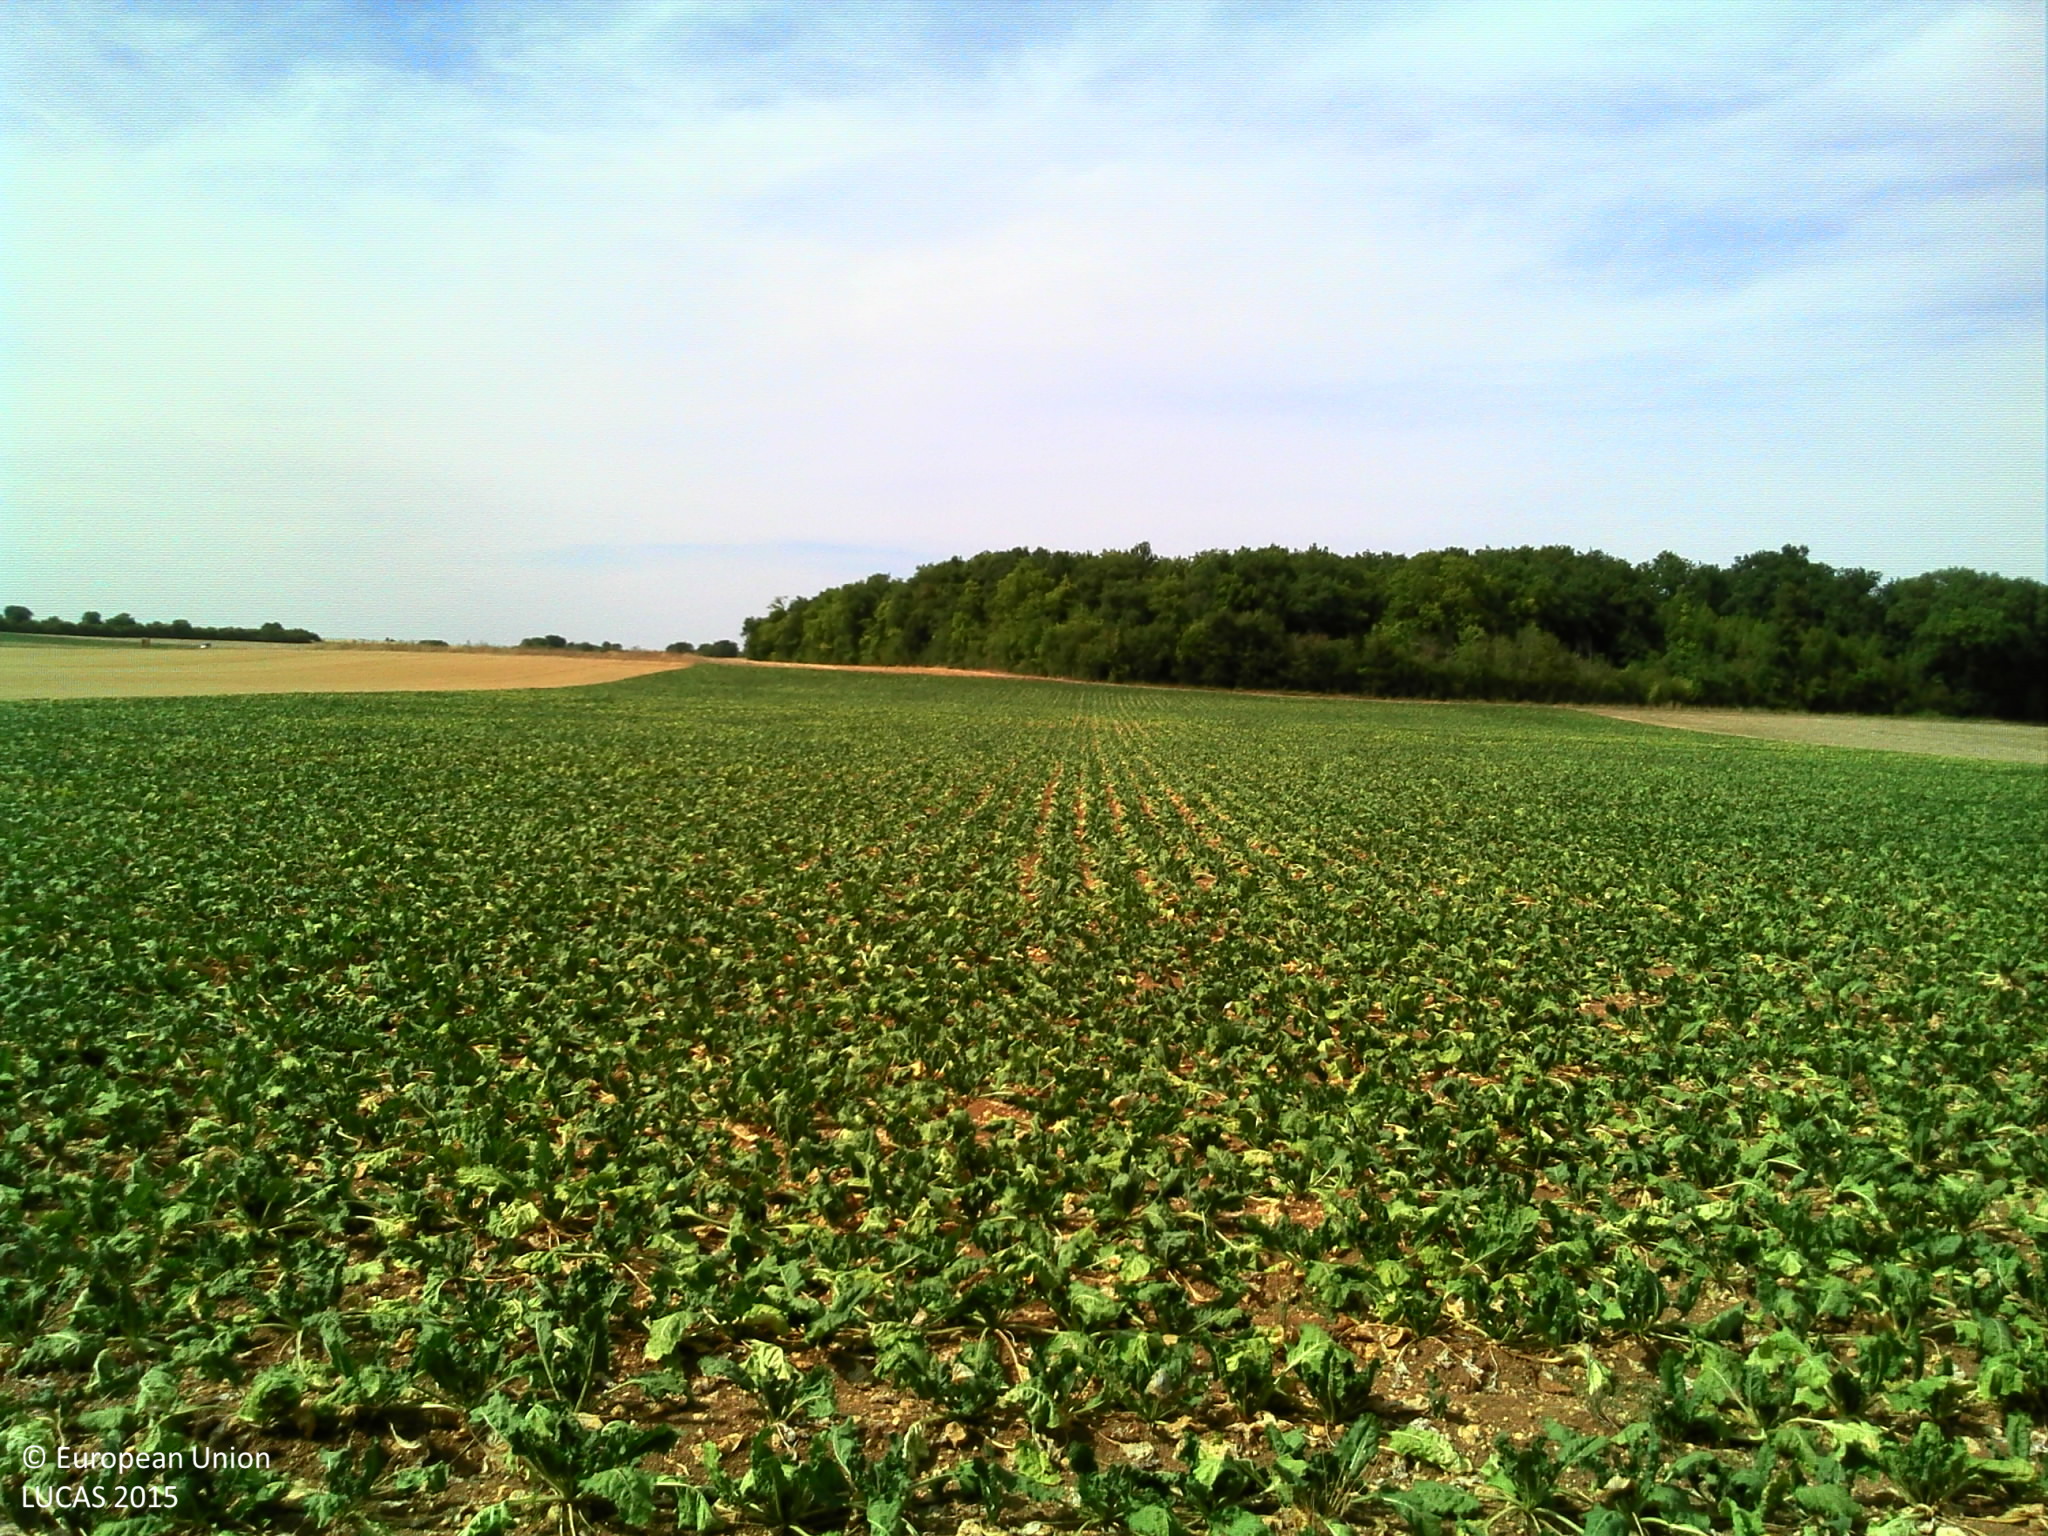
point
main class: Cropland
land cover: Sugar beet
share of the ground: > 75 %
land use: Agriculture (excluding fallow land and kitchen gardens)
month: August
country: FR
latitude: 48.1649
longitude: 2.4740
